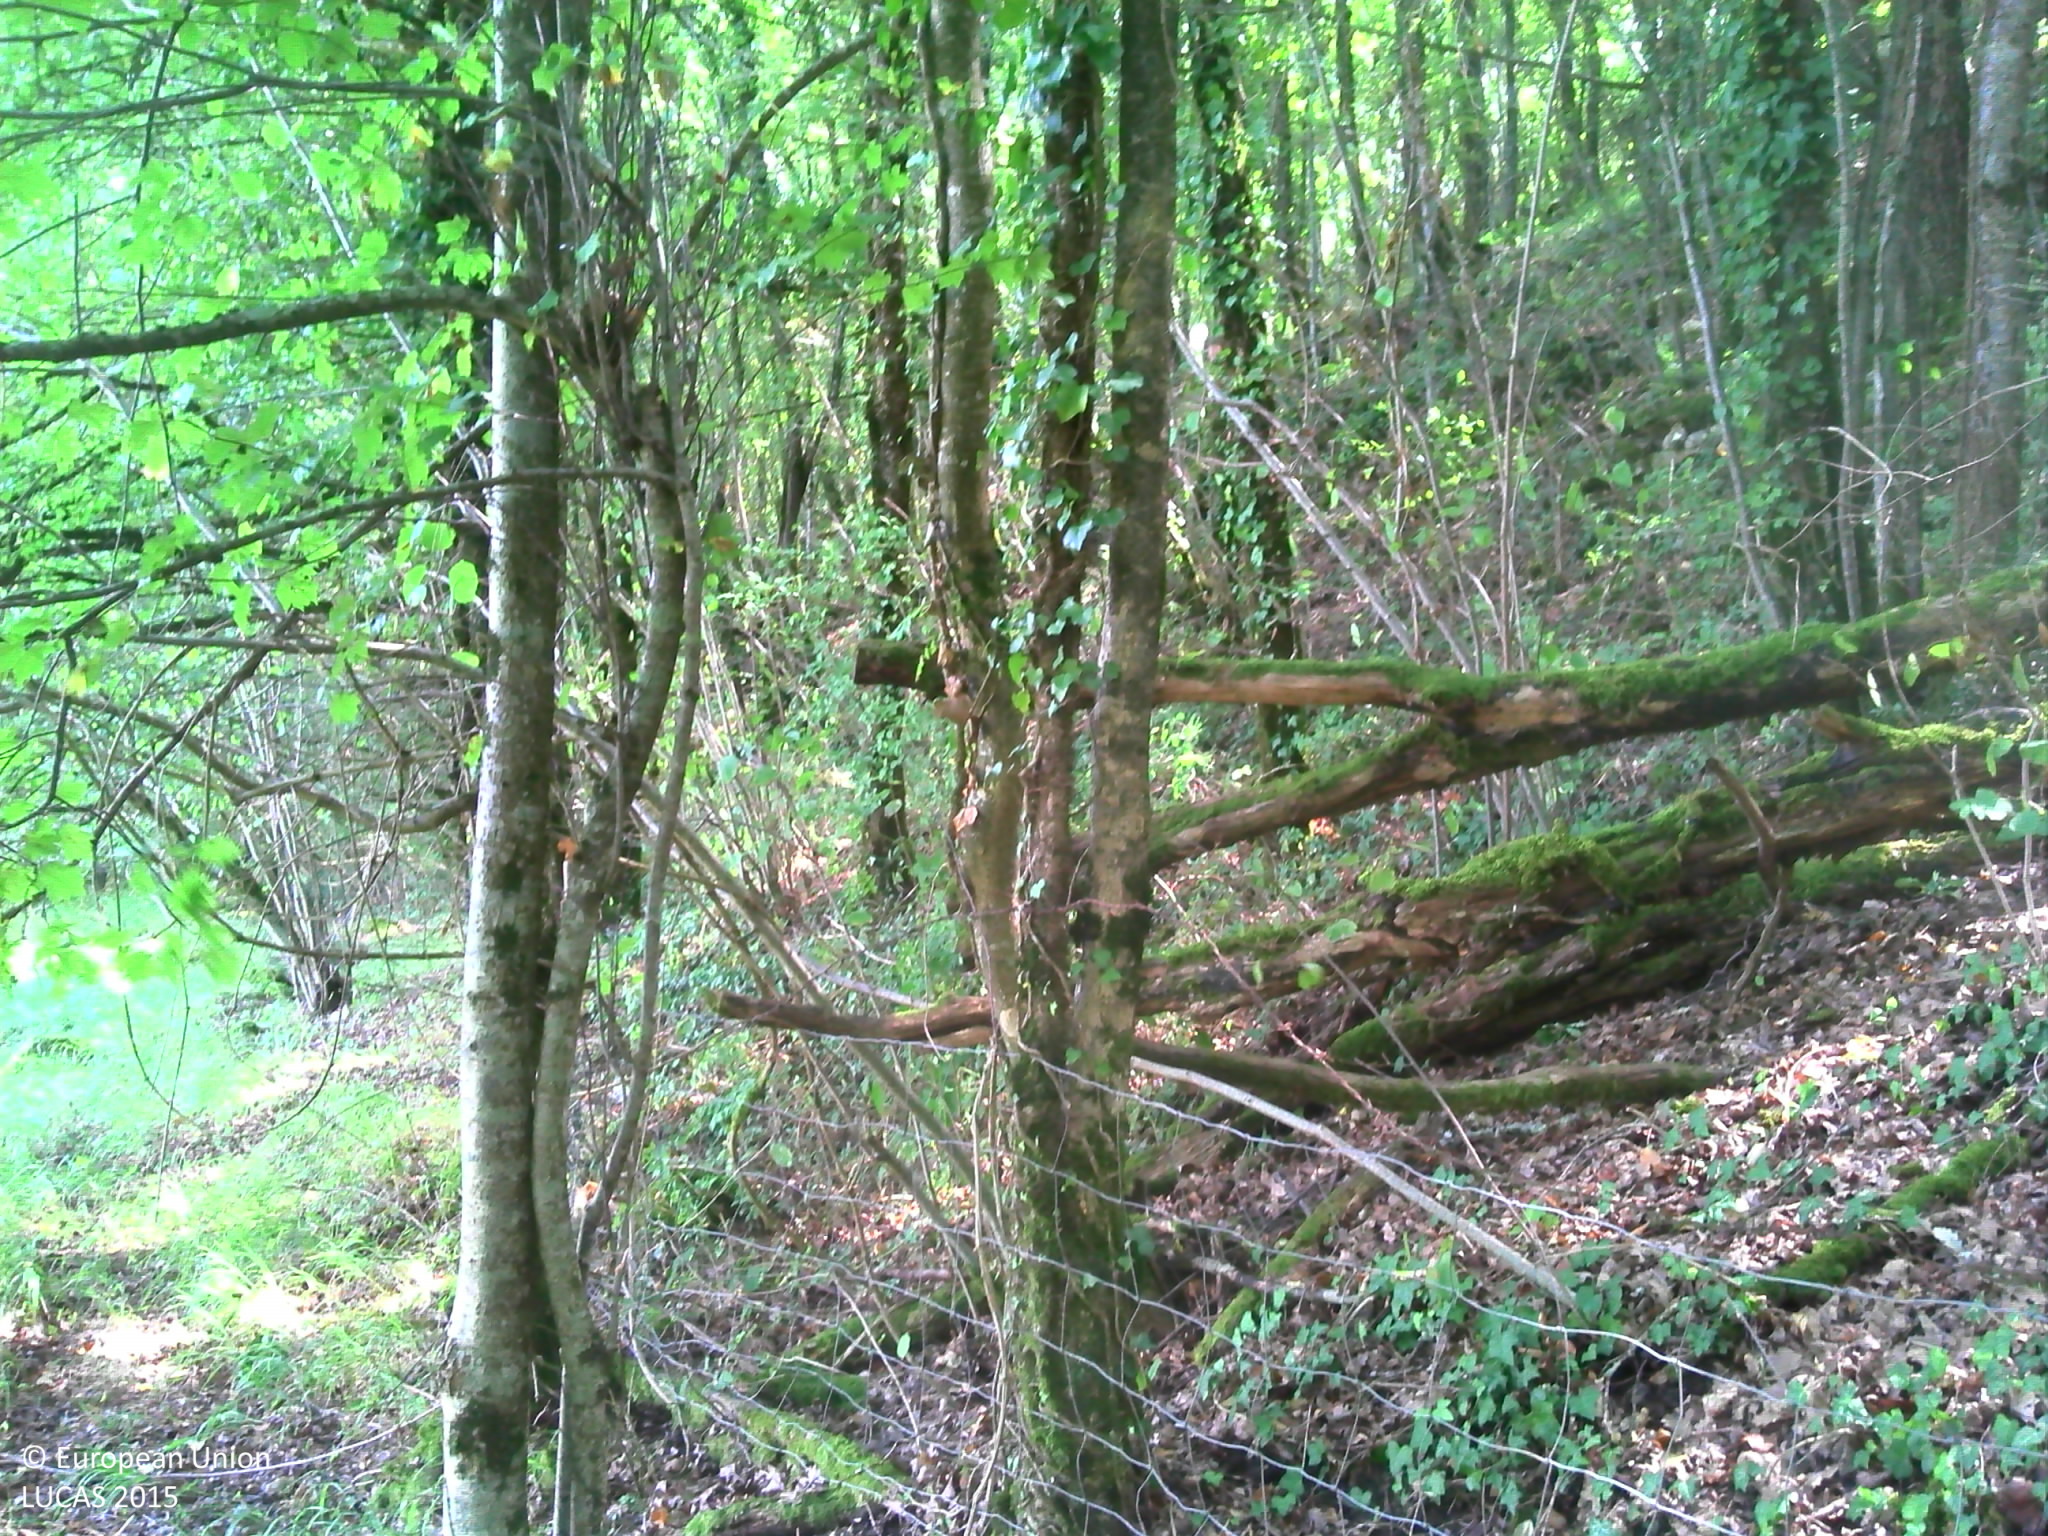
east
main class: Woodland
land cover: Broadleaved woodland
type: thermophilous deciduous forest
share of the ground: > 75 %
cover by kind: broadleaved forest trees 90 %, herbaceous plants 5 %, lichens and mosses 5 %
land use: Forestry
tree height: > 5 m
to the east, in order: Broadleaved woodland; Fences; Broadleaved woodland; Dry stone walls; Broadleaved woodland; Grass margins; Paved roads, cycling and walking lanes; Broadleaved woodland; Artificial constructions in urban areas; Spontaneously vegetated surfaces; Broadleaved woodland; Fences; Shrubland without tree cover; Dry stone walls; Broadleaved woodland
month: August
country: FR
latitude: 44.8618
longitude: 1.8354
